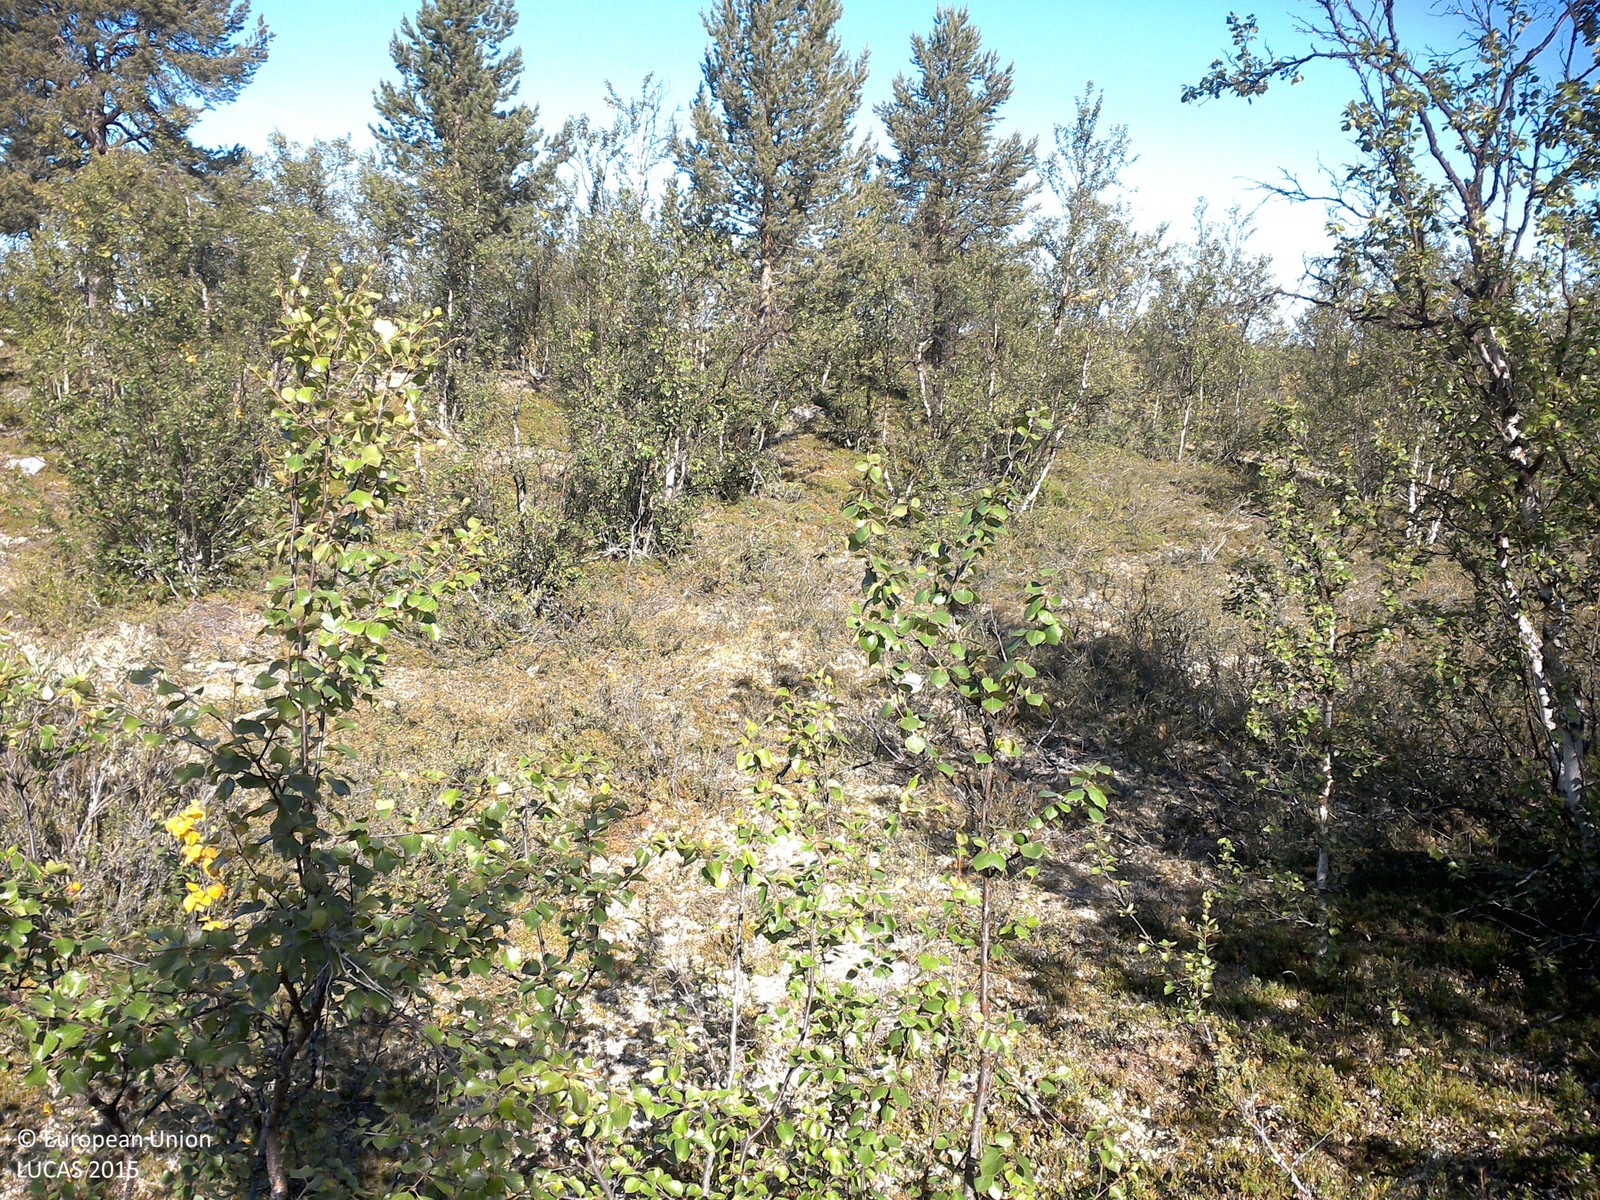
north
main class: Woodland
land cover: Broadleaved woodland
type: boreal forest
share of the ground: 10 - 25 %
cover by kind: shrubs 65 %, broadleaved forest trees 15 %, lichens and mosses 15 %, coniferous forest trees 5 %
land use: Amenities, museums, leisure
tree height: < 5 m
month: August
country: SE
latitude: 67.5457
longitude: 20.1013
